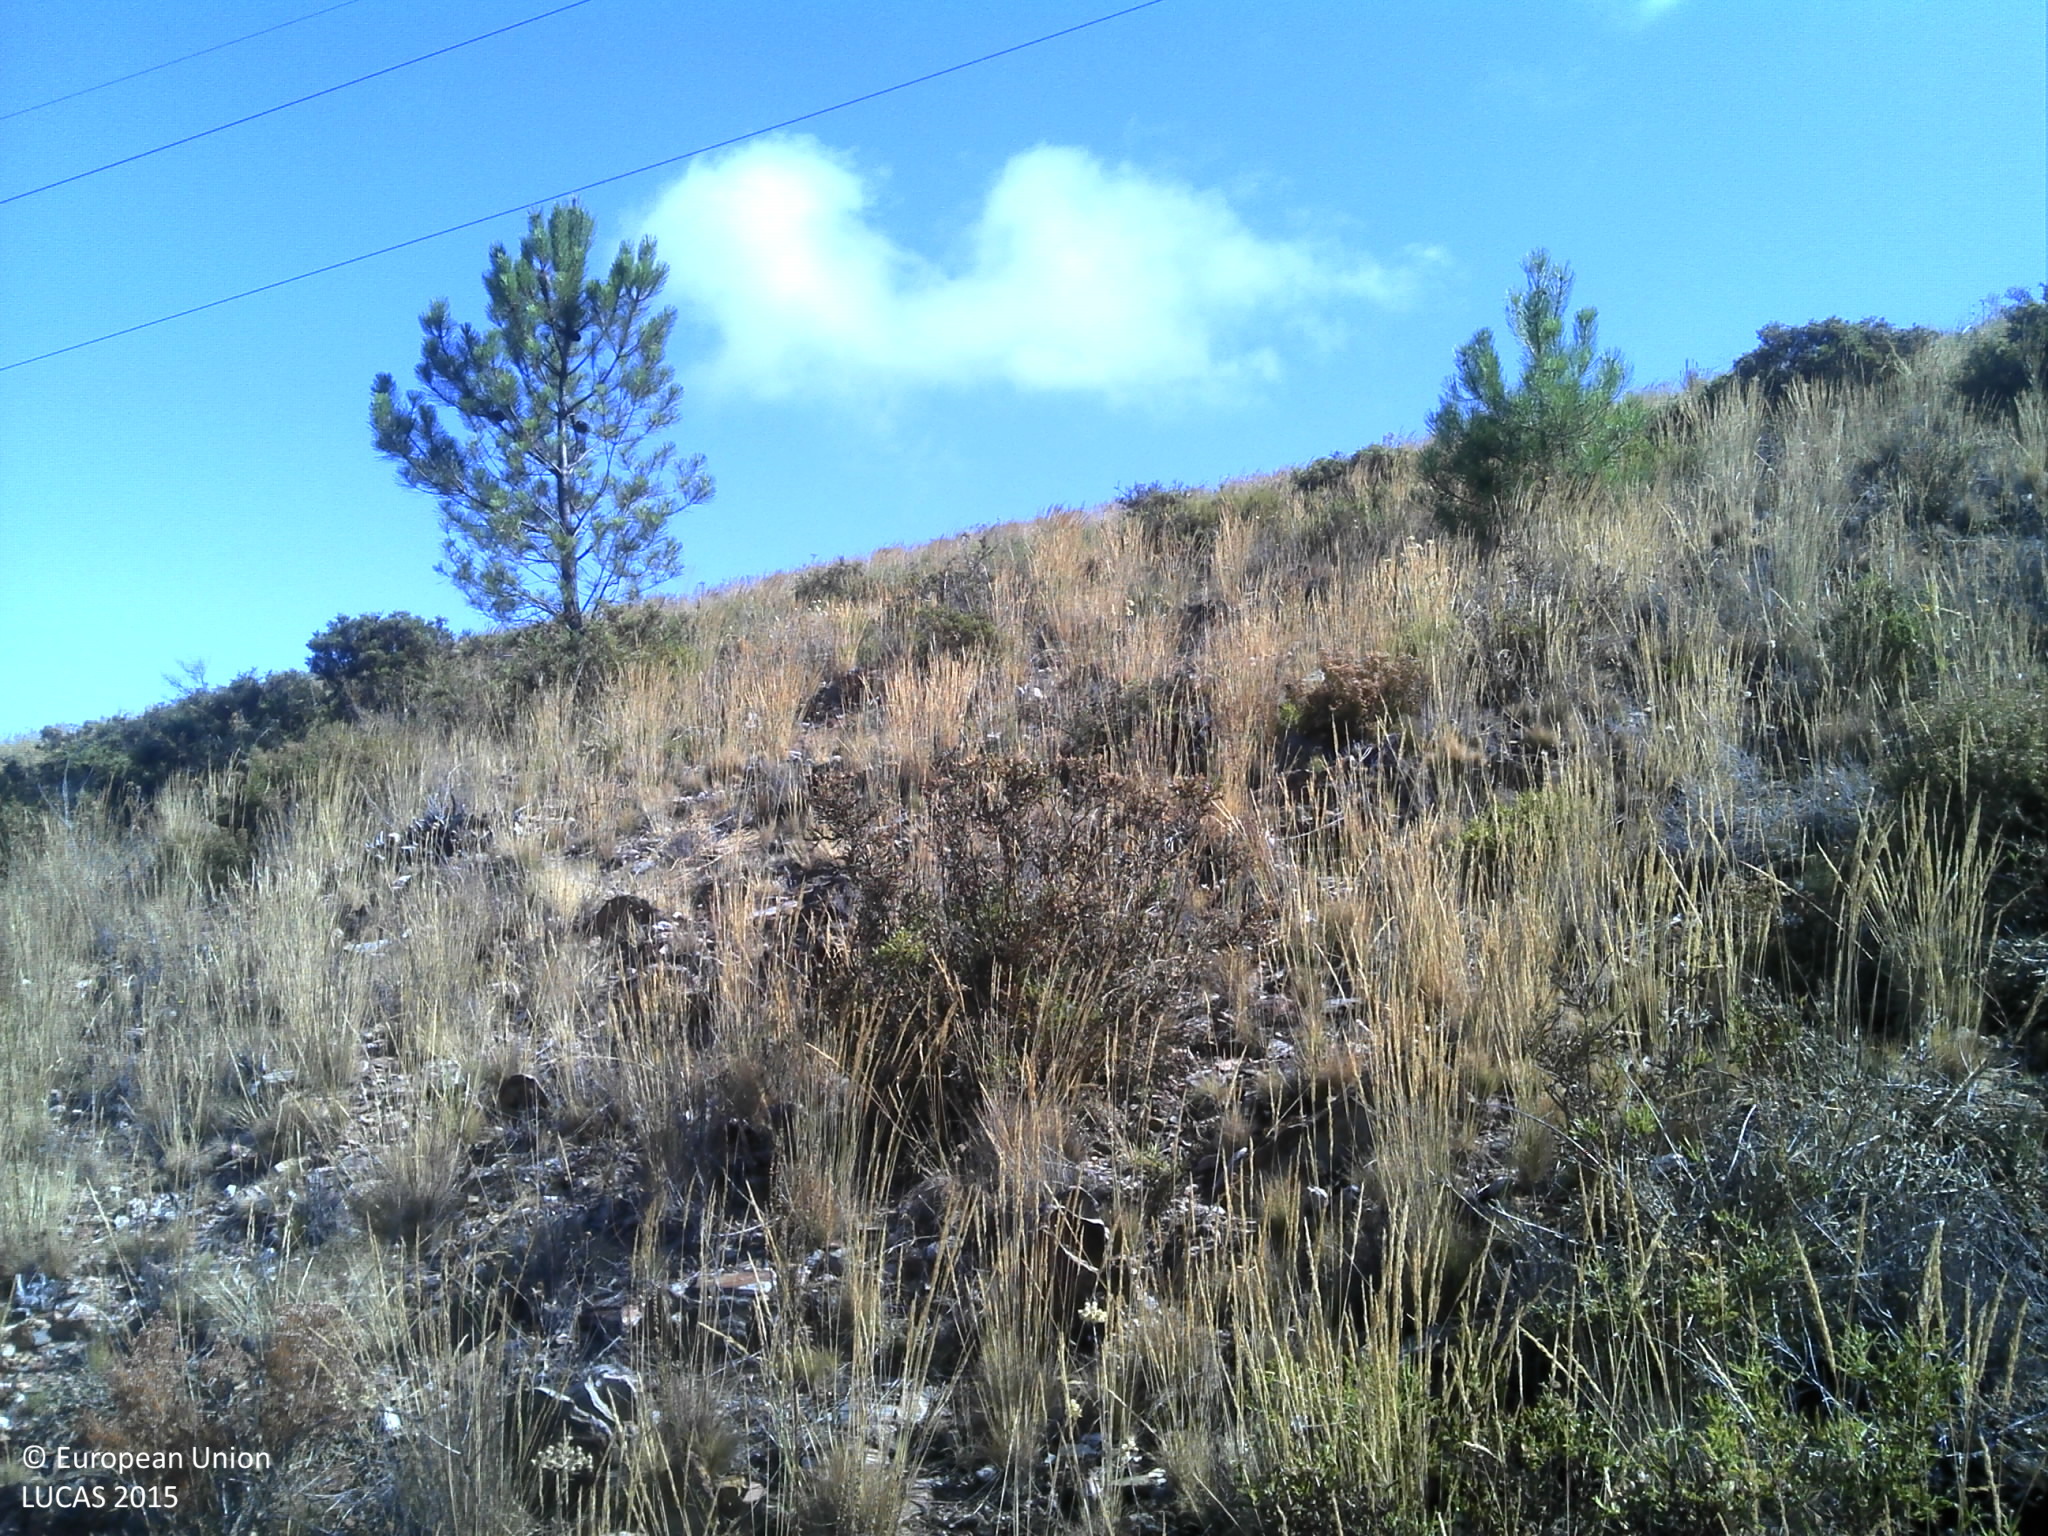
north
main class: Shrubland
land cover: Shrubland without tree cover
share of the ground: > 75 %
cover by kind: shrubs 75 %, unconsolidated bare surface 25 %
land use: Semi-natural and natural areas not in use
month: July
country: PT
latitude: 40.1357
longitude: -7.9197
